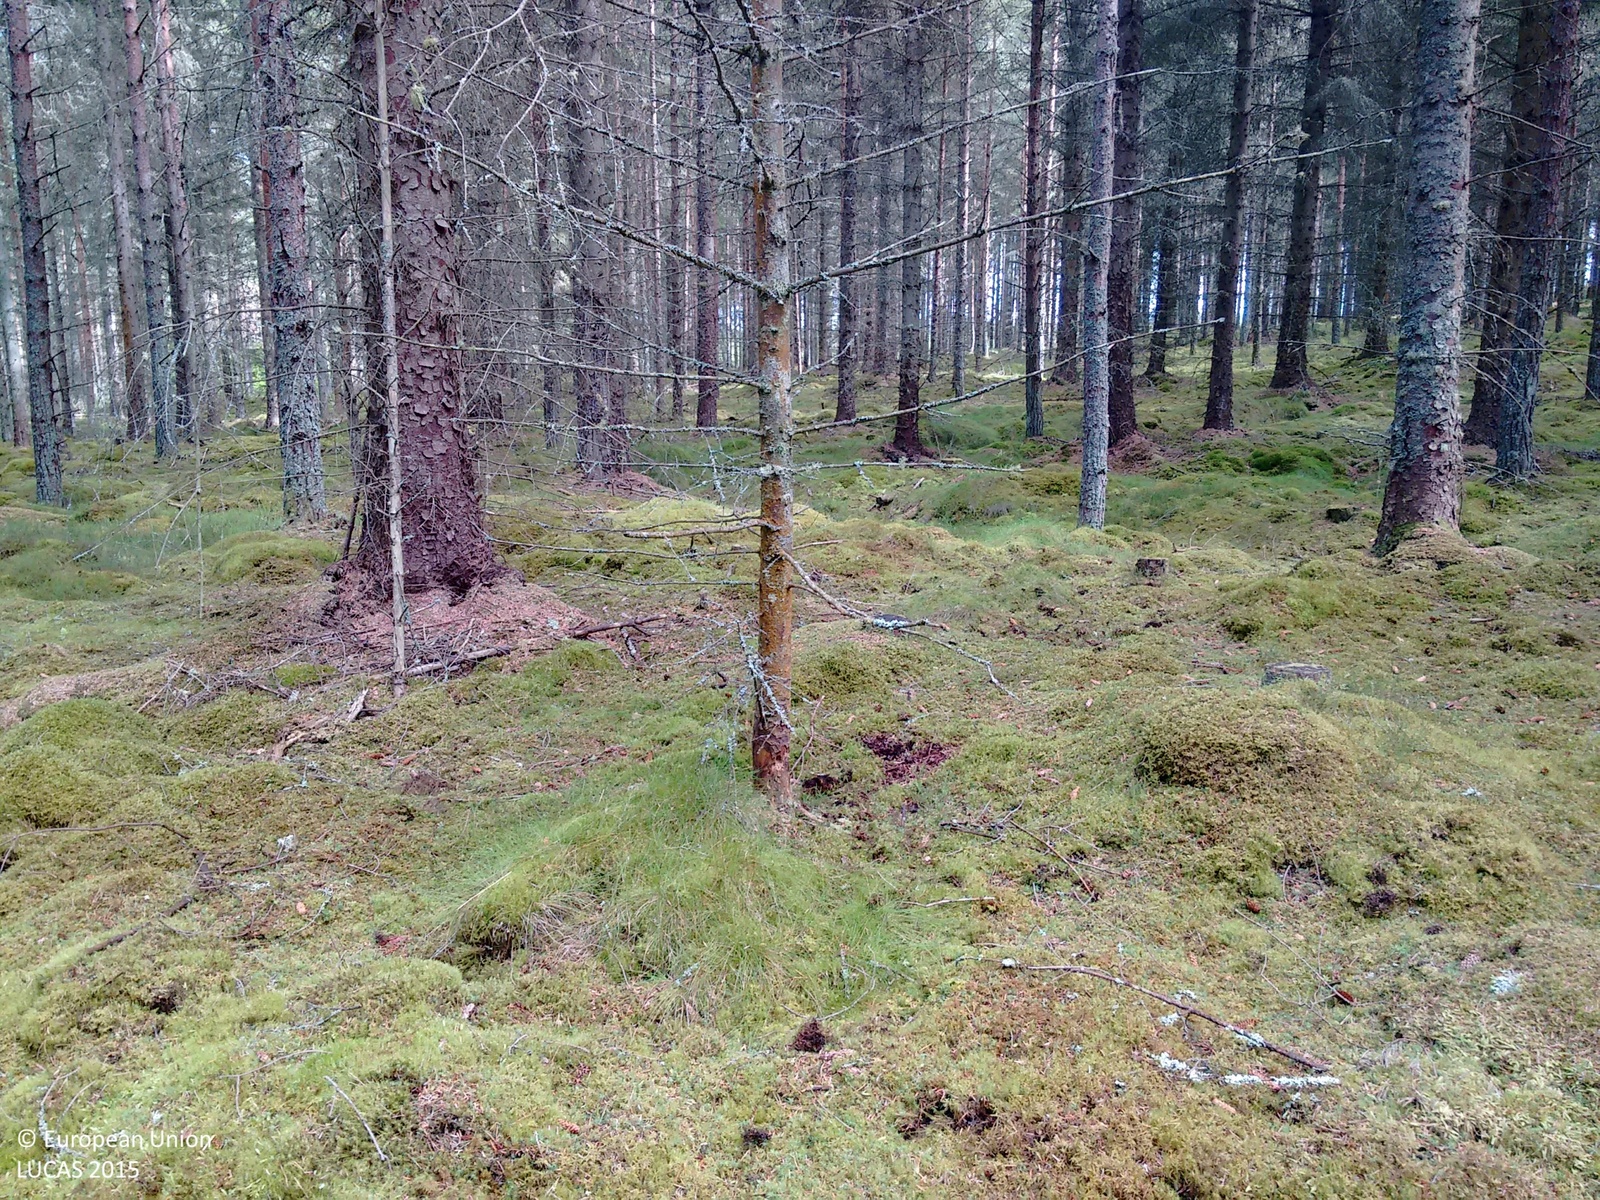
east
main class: Woodland
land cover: Spruce dominated coniferous woodland
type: exotic forest
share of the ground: > 75 %
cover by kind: coniferous forest trees 80 %, lichens and mosses 15 %, broadleaved forest trees 5 %
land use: Forestry
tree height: > 5 m
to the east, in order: Spruce dominated coniferous woodland; Ditches and canals; Lichens and moss; Other bare soil; Spruce dominated coniferous woodland; Spontaneously vegetated surfaces
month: August
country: GB
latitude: 57.6723
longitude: -2.8504
